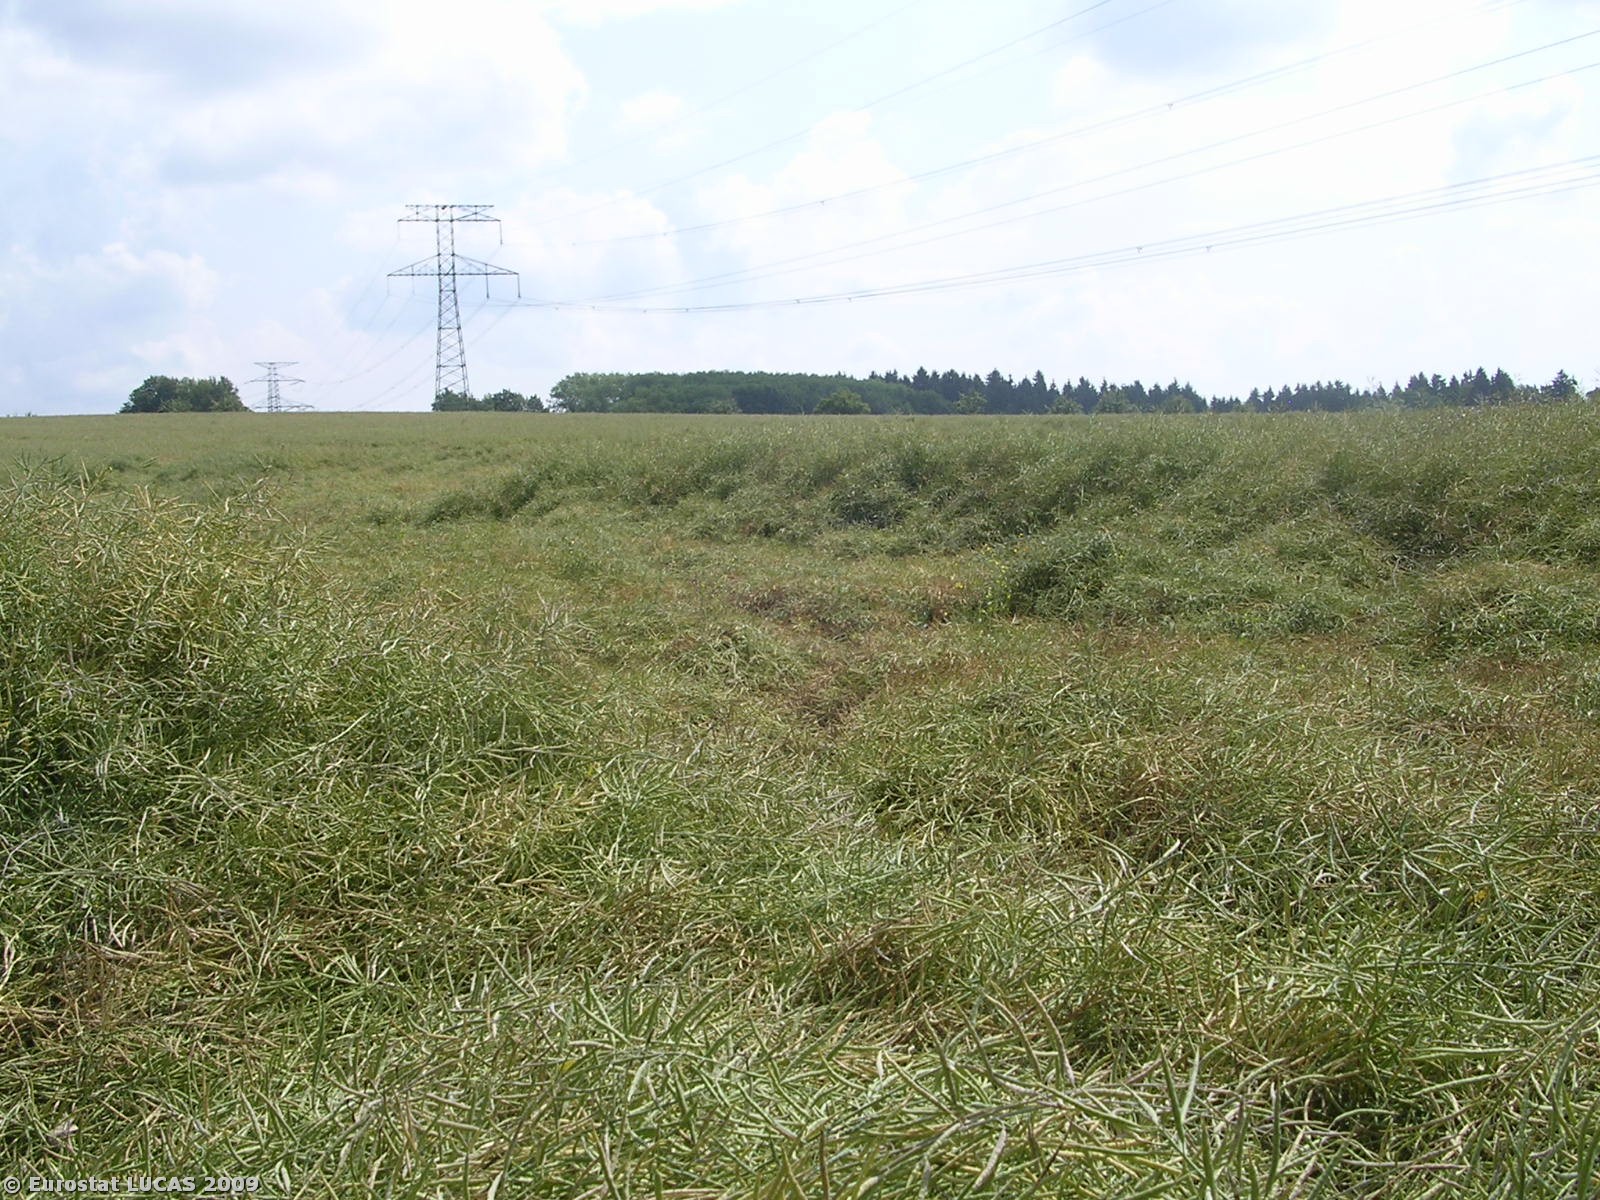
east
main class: Cropland
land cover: Rape and turnip rape
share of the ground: > 75 %
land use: Agriculture (excluding fallow land and kitchen gardens)
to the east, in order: Rape and turnip rape; Electric lines; Rape and turnip rape
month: July
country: CZ
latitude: 50.6130
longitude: 15.0482
